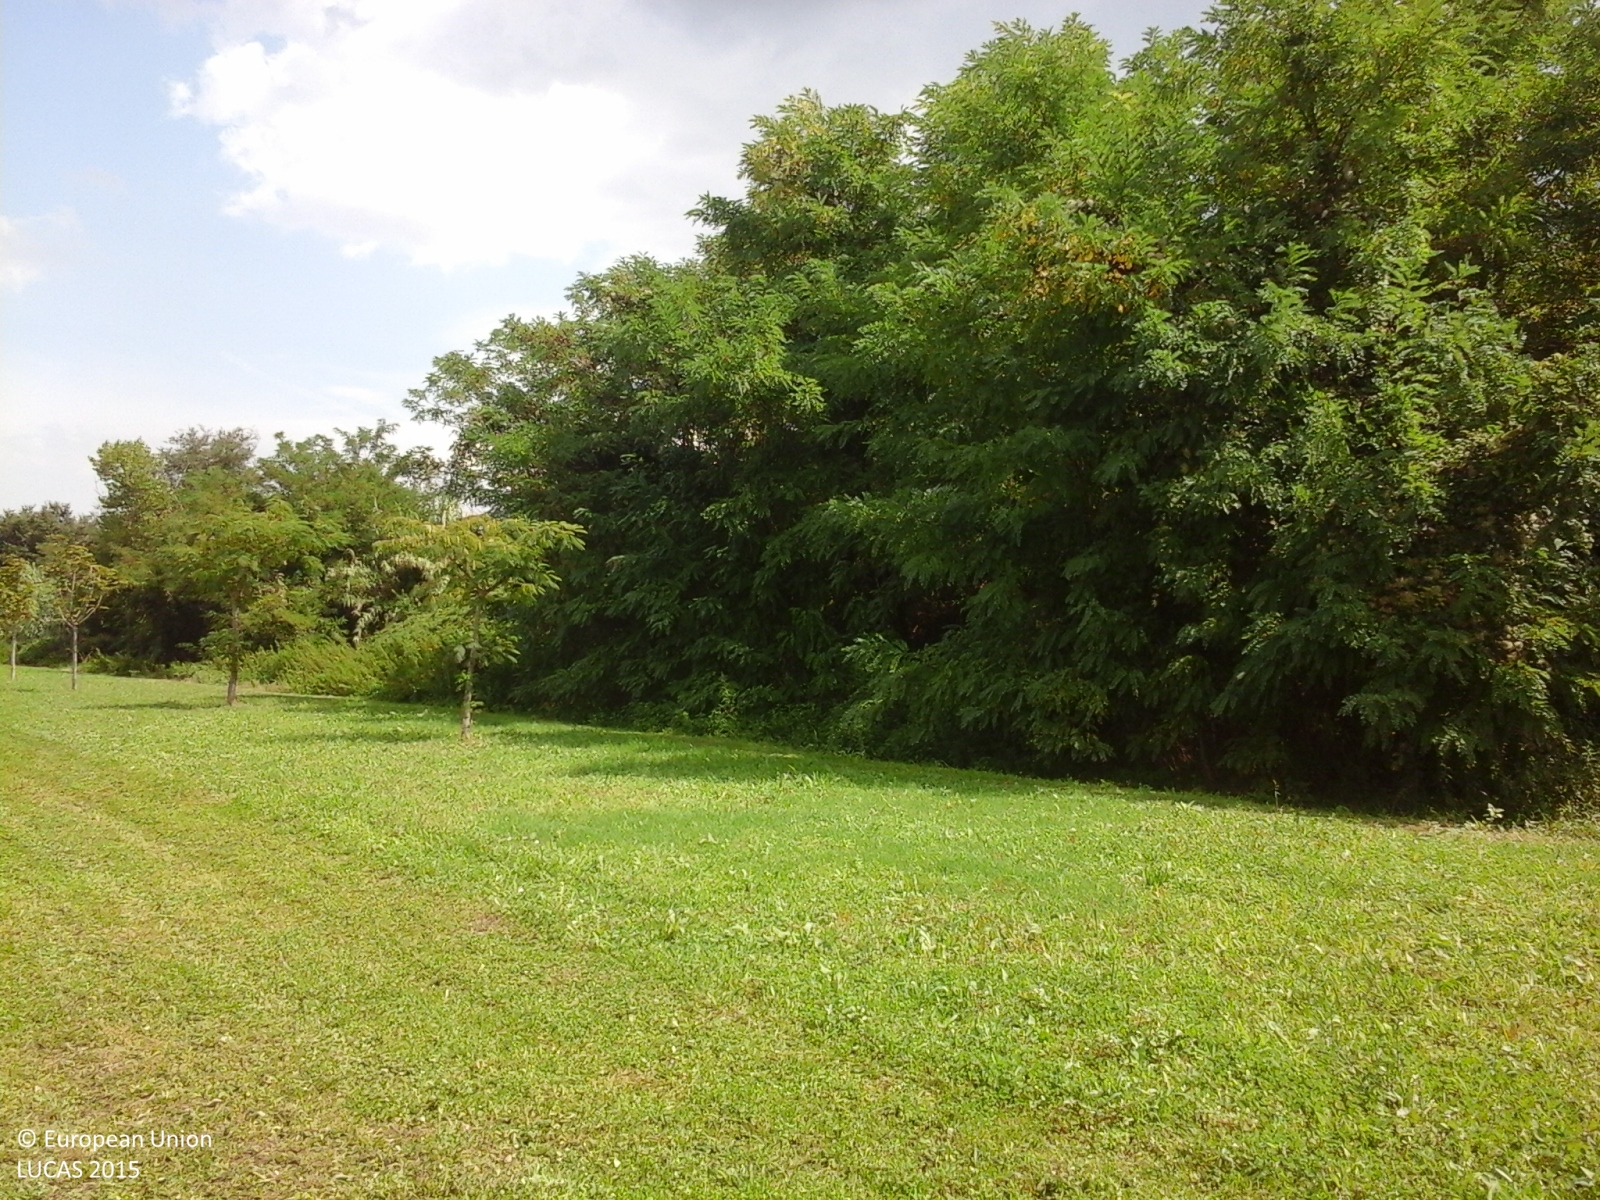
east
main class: Grassland
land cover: Grassland without tree/shrub cover
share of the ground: > 75 %
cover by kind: herbaceous plants 100 %
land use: Community services
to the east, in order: Grassland without tree/shrub cover; Broadleaved woodland; Ditches and canals; Broadleaved woodland; Paved roads, cycling and walking lanes; Broadleaved woodland; Paved roads, cycling and walking lanes; Broadleaved woodland; Paved roads, cycling and walking lanes; Grass margins; Fences; Abandoned hedges; Spontaneously vegetated surfaces
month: August
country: IT
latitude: 43.4882
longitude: 13.2193
